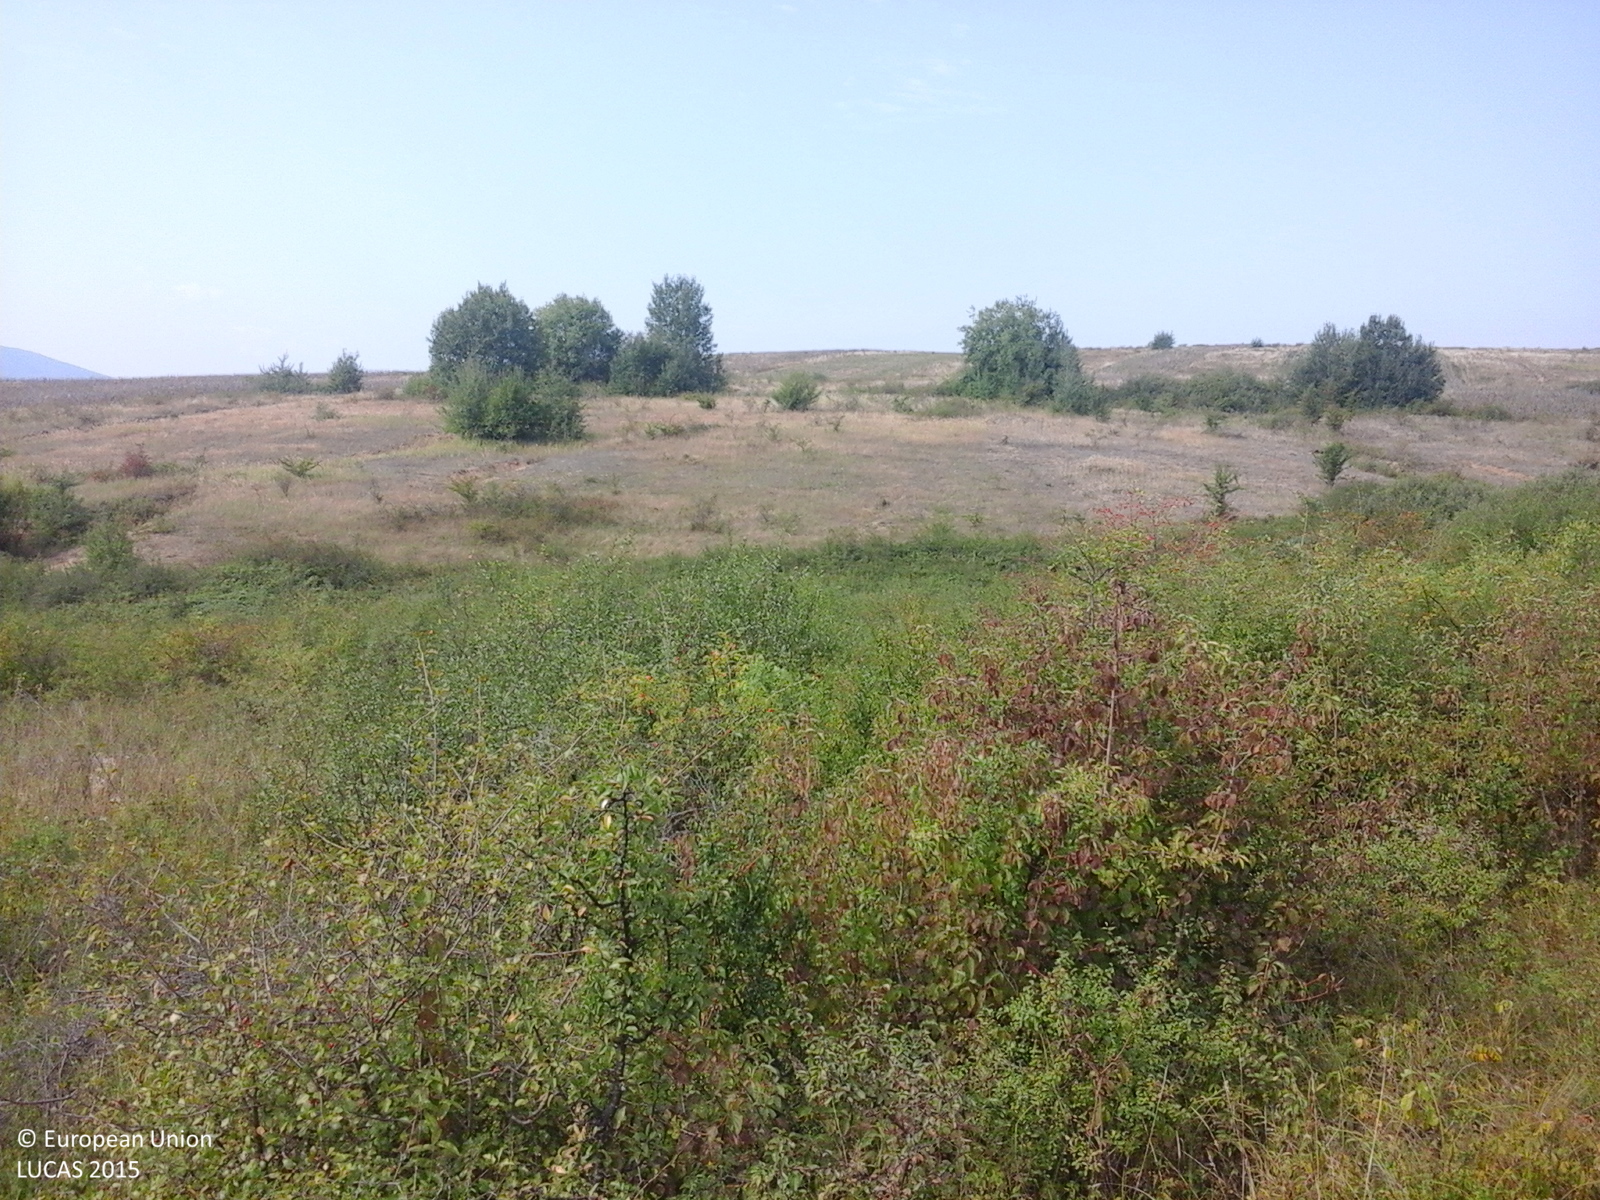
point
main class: Shrubland
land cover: Shrubland with sparse tree cover
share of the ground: > 75 %
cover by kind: shrubs 95 %, broadleaved forest trees 5 %
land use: Forestry
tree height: < 5 m
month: August
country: RO
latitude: 46.3394
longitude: 22.2201
